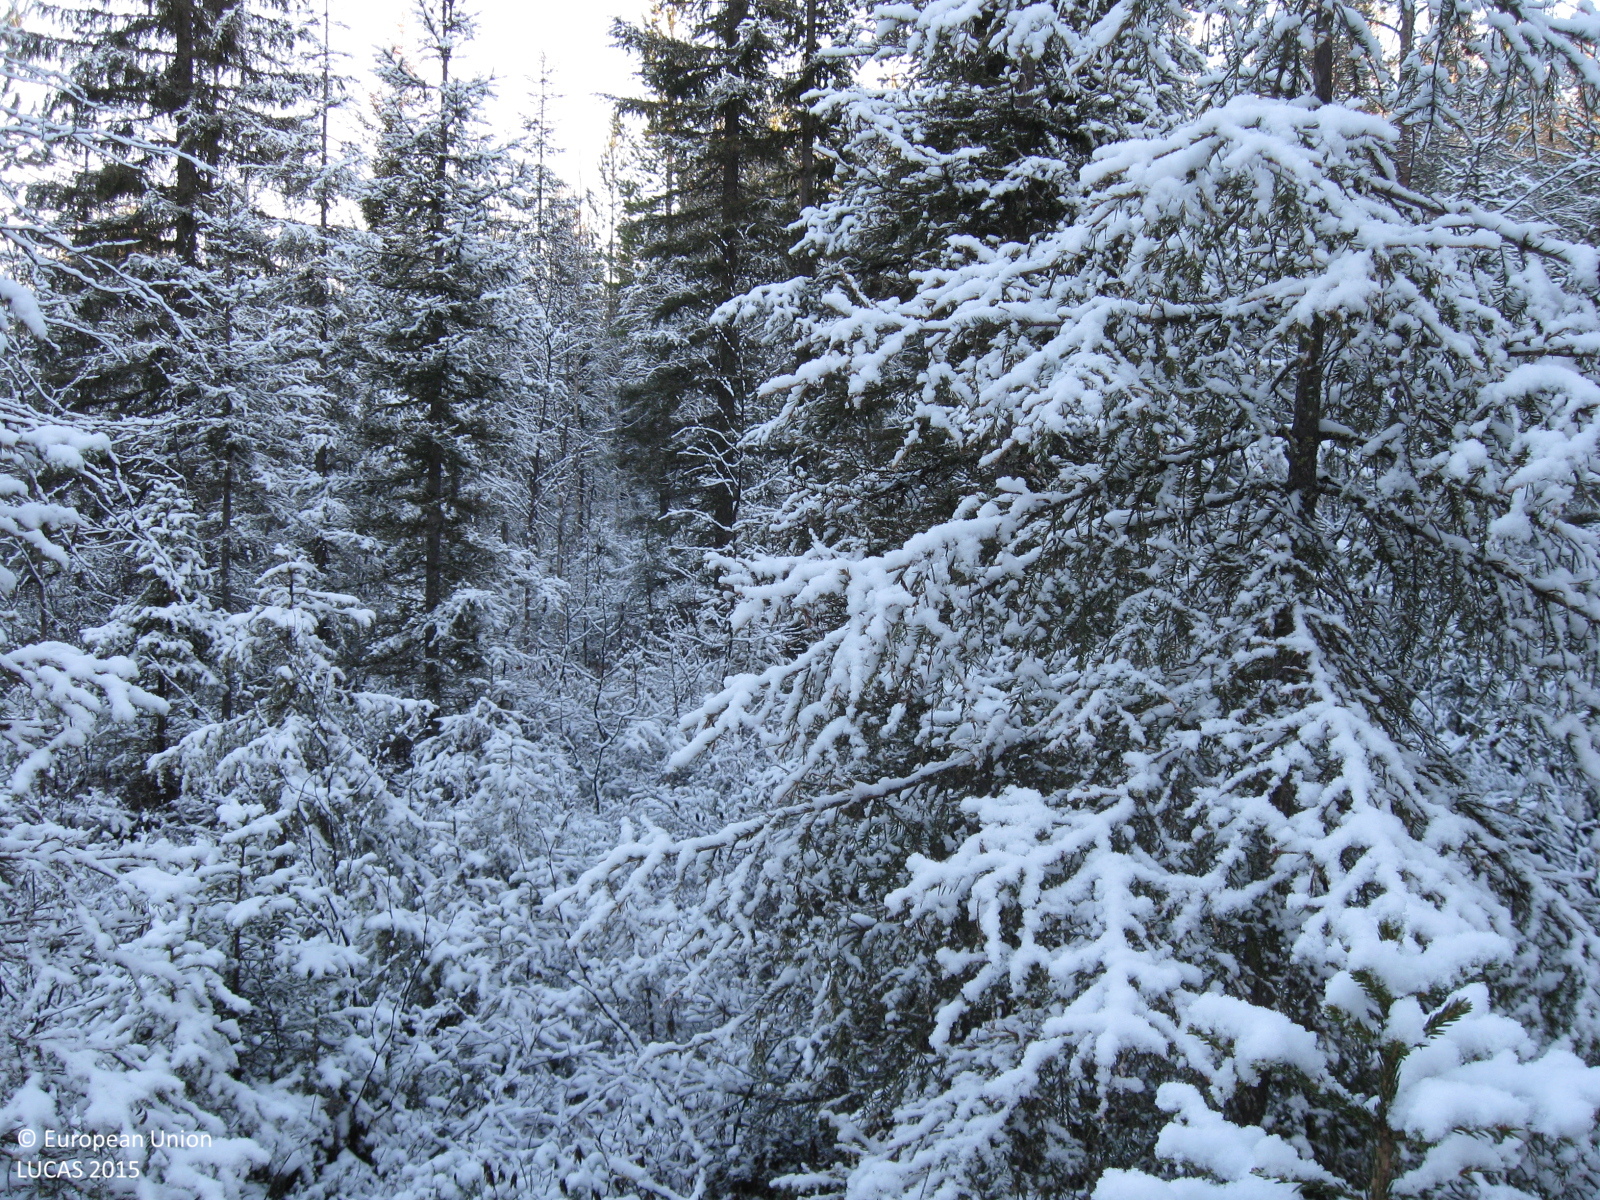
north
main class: Woodland
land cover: Spruce dominated mixed woodland
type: boreal forest
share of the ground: 50 - 75 %
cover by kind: coniferous forest trees 35 %, broadleaved forest trees 25 %, shrubs 20 %, herbaceous plants 10 %, lichens and mosses 10 %
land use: Forestry
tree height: > 5 m
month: October
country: SE
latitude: 66.3430
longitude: 21.4659
